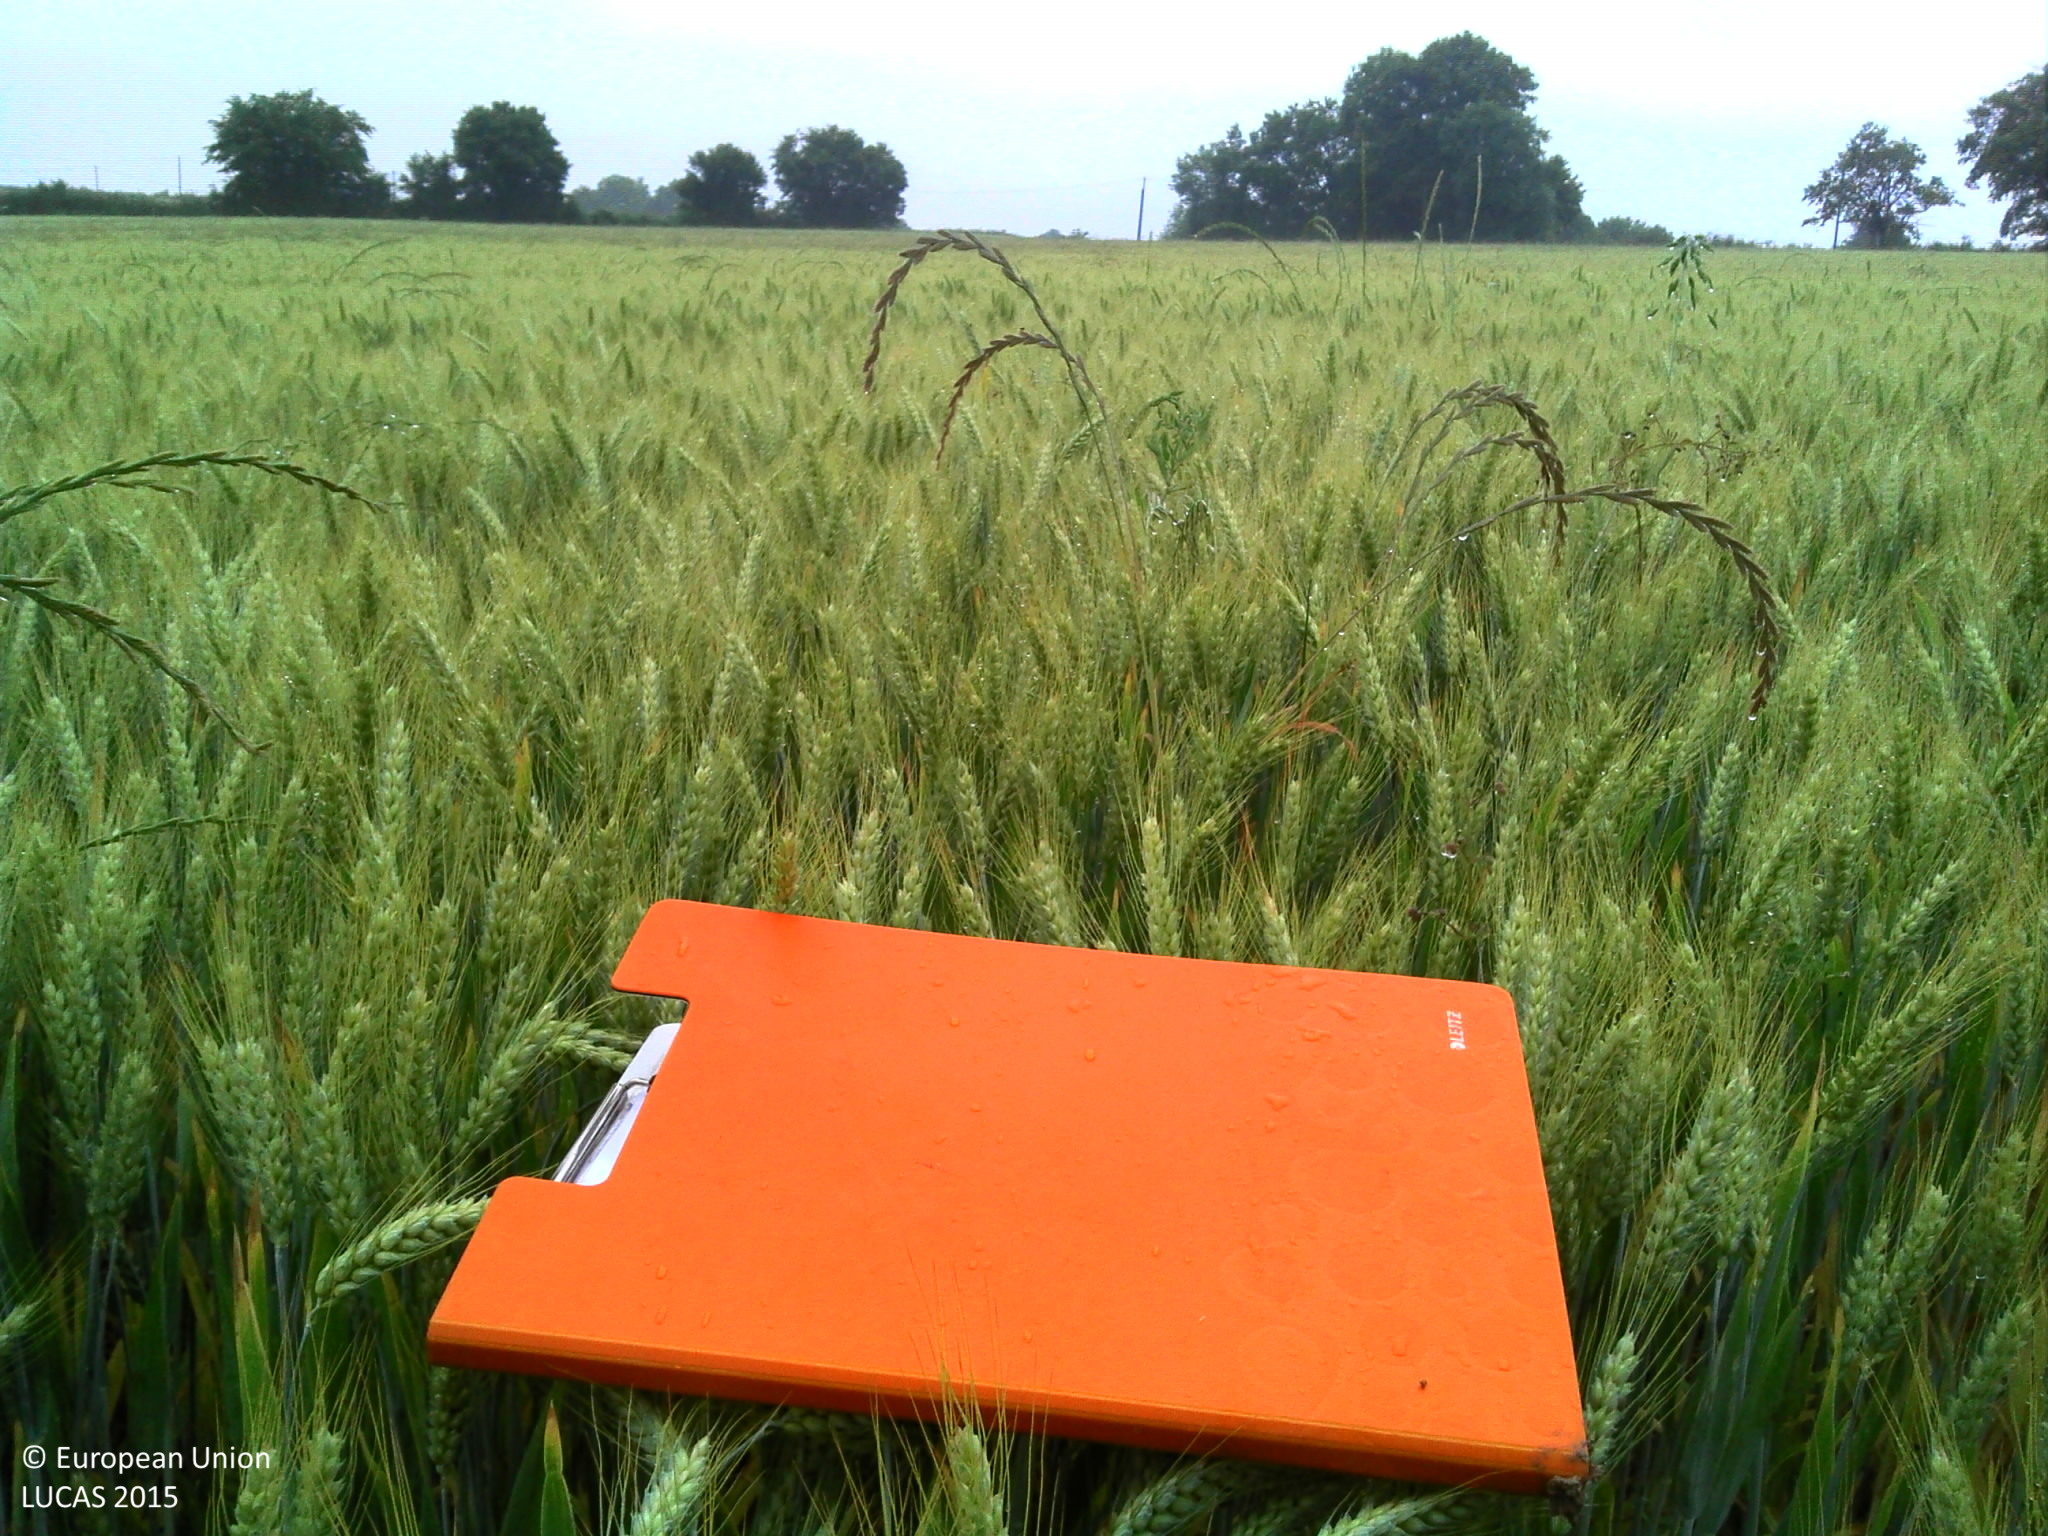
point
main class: Cropland
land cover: Common wheat
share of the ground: > 75 %
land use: Agriculture (excluding fallow land and kitchen gardens)
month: June
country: FR
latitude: 47.4724
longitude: 2.6554
